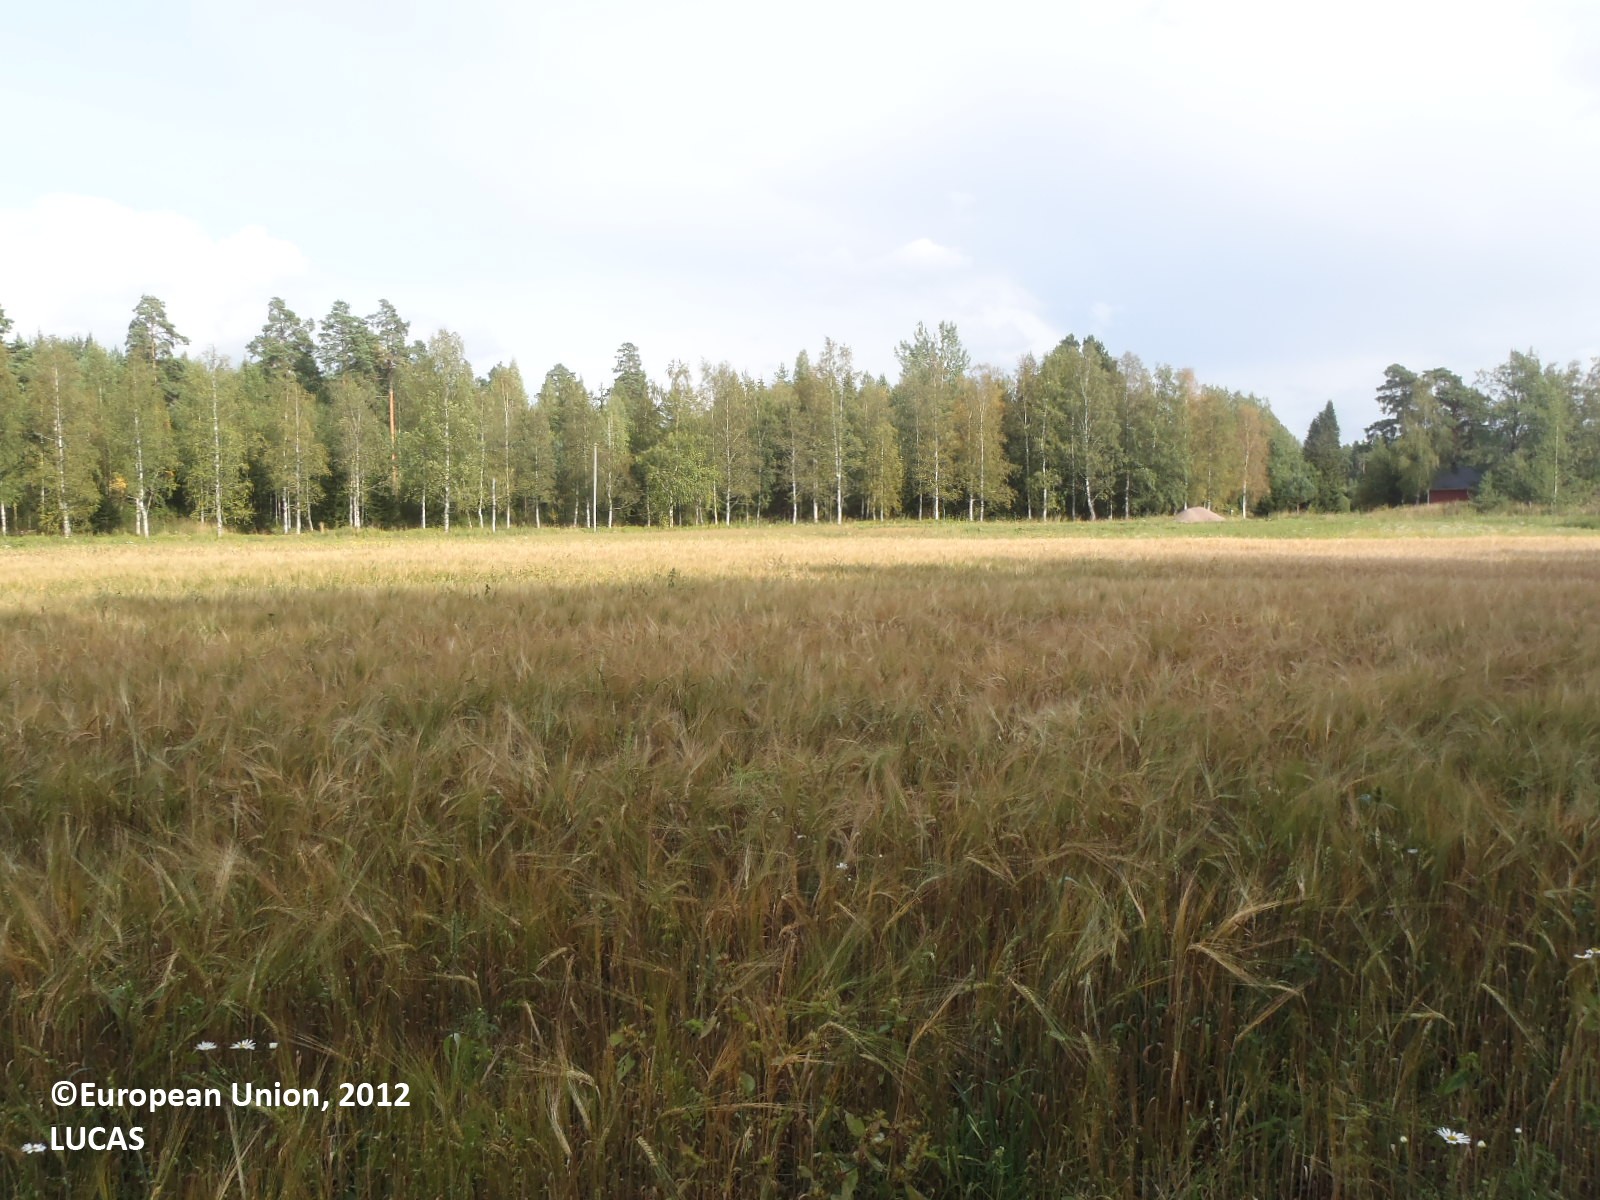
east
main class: Cropland
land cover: Mixed cereals for fodder
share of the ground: > 75 %
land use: Agriculture (excluding fallow land and kitchen gardens)
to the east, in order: Mixed cereals for fodder; Grass margins; Ditches and canals; Lines of trees; Paved roads, cycling and walking lanes; Grass margins; Lines of trees; Pine dominated mixed woodland; Inland running water; Pine dominated mixed woodland; Tracks; Pine dominated mixed woodland; Tracks; Broadleaved woodland
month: August
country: FI
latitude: 60.5031
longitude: 22.6538
